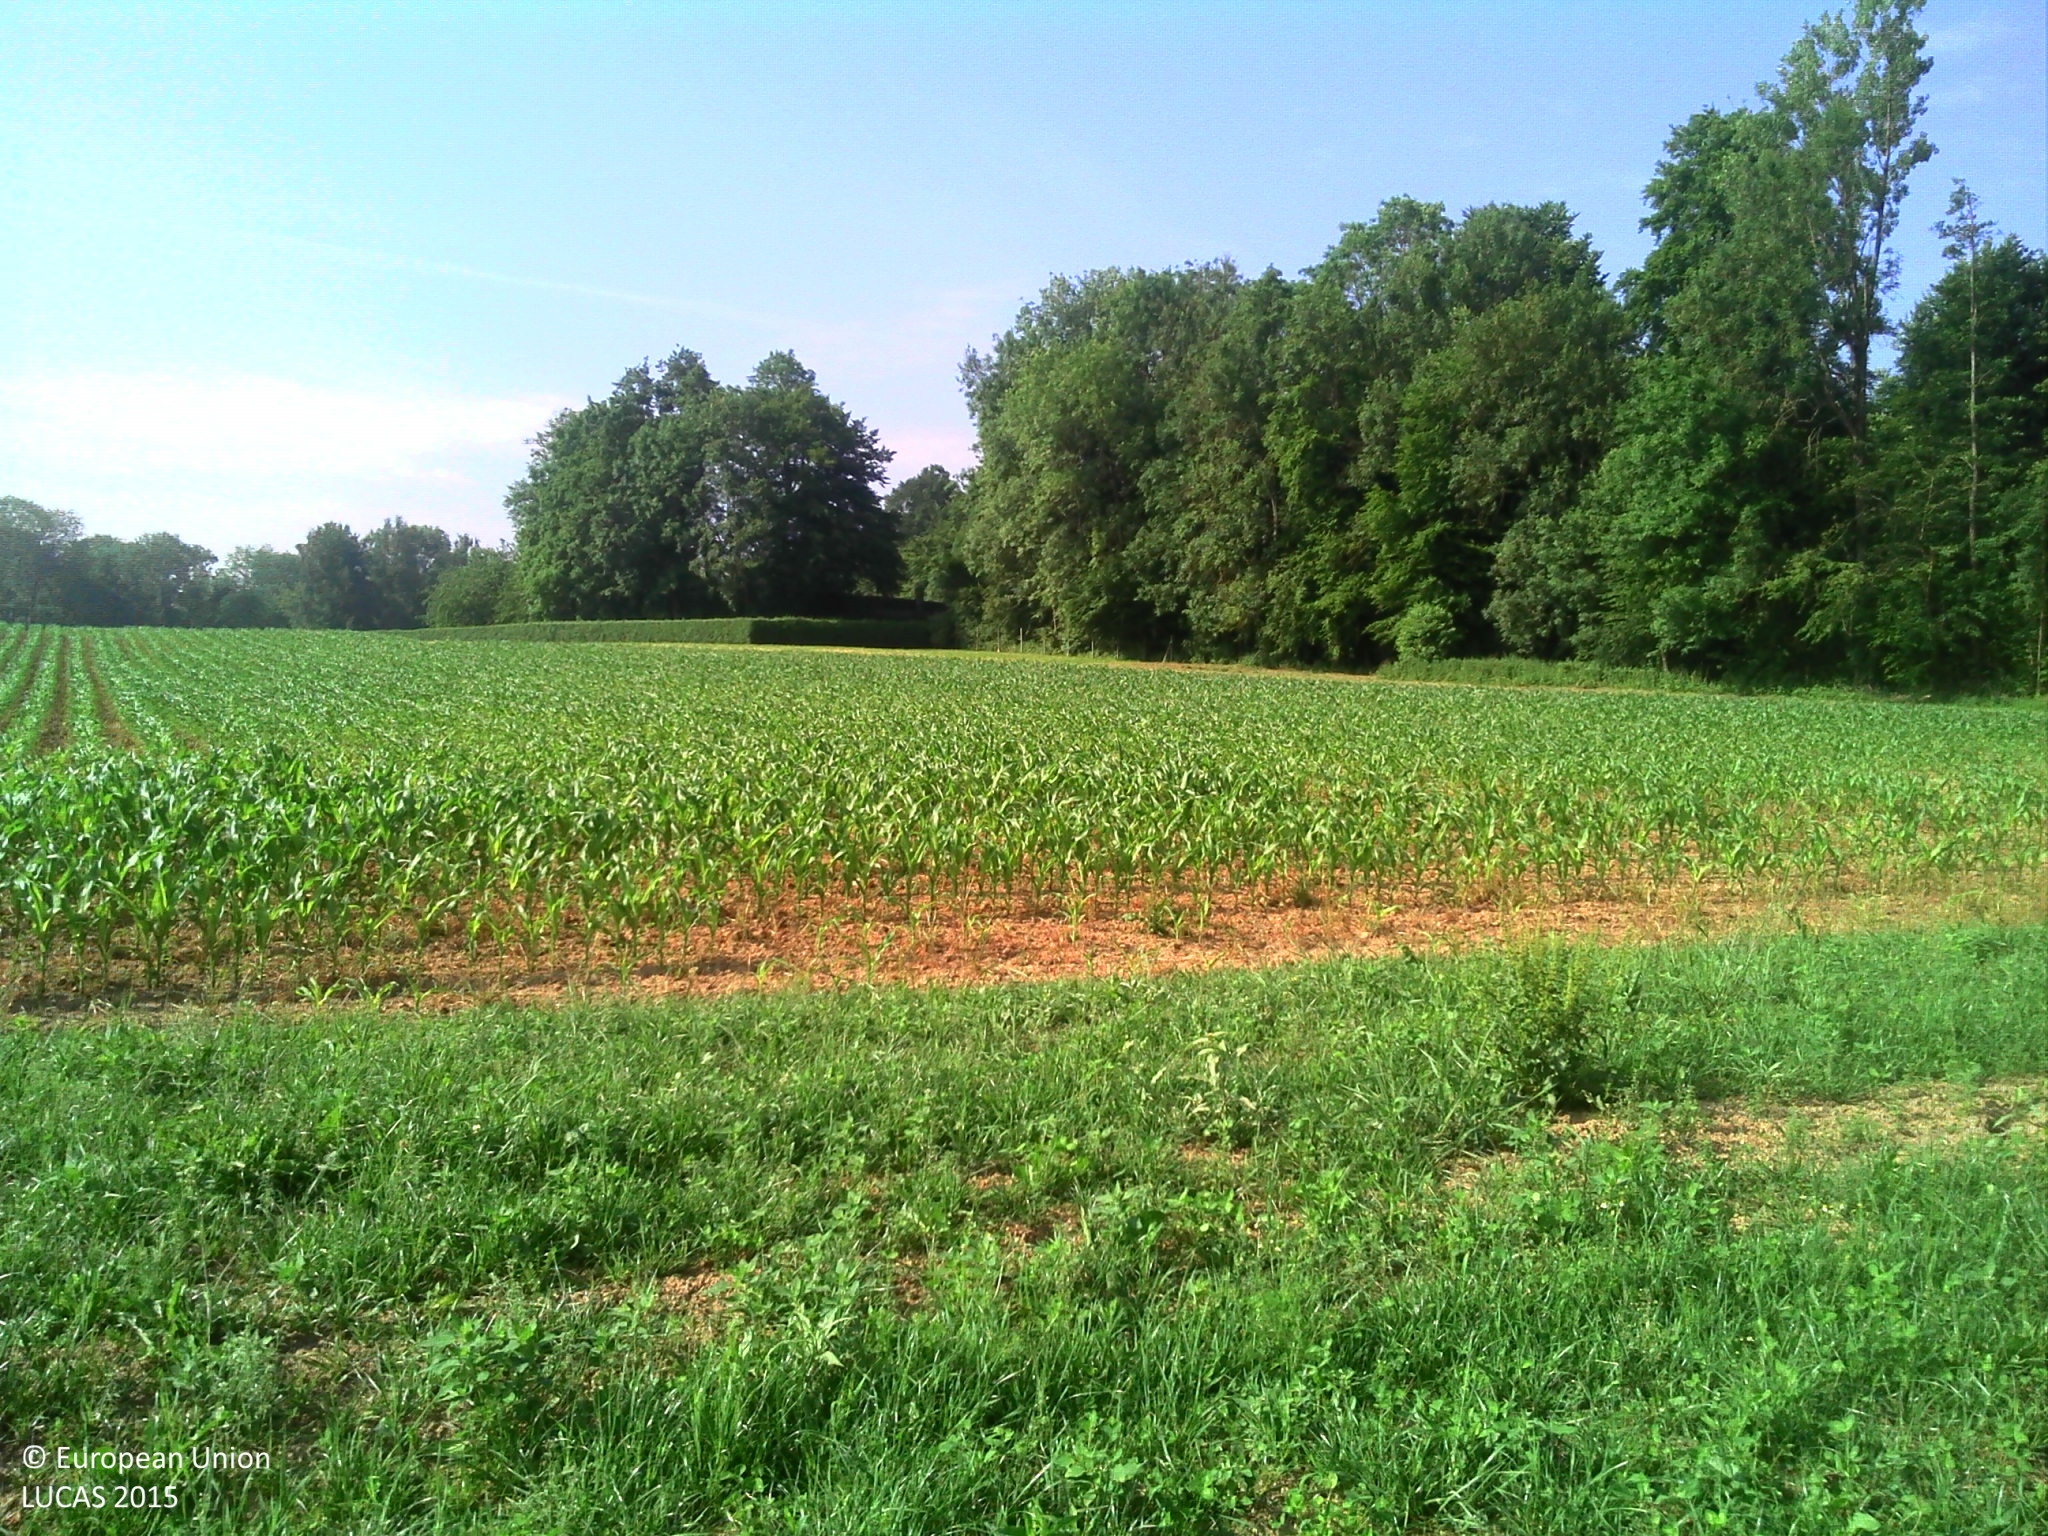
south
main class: Cropland
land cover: Temporary grasslands
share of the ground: > 75 %
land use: Agriculture (excluding fallow land and kitchen gardens)
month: June
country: FR
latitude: 47.5809
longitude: 7.4090
